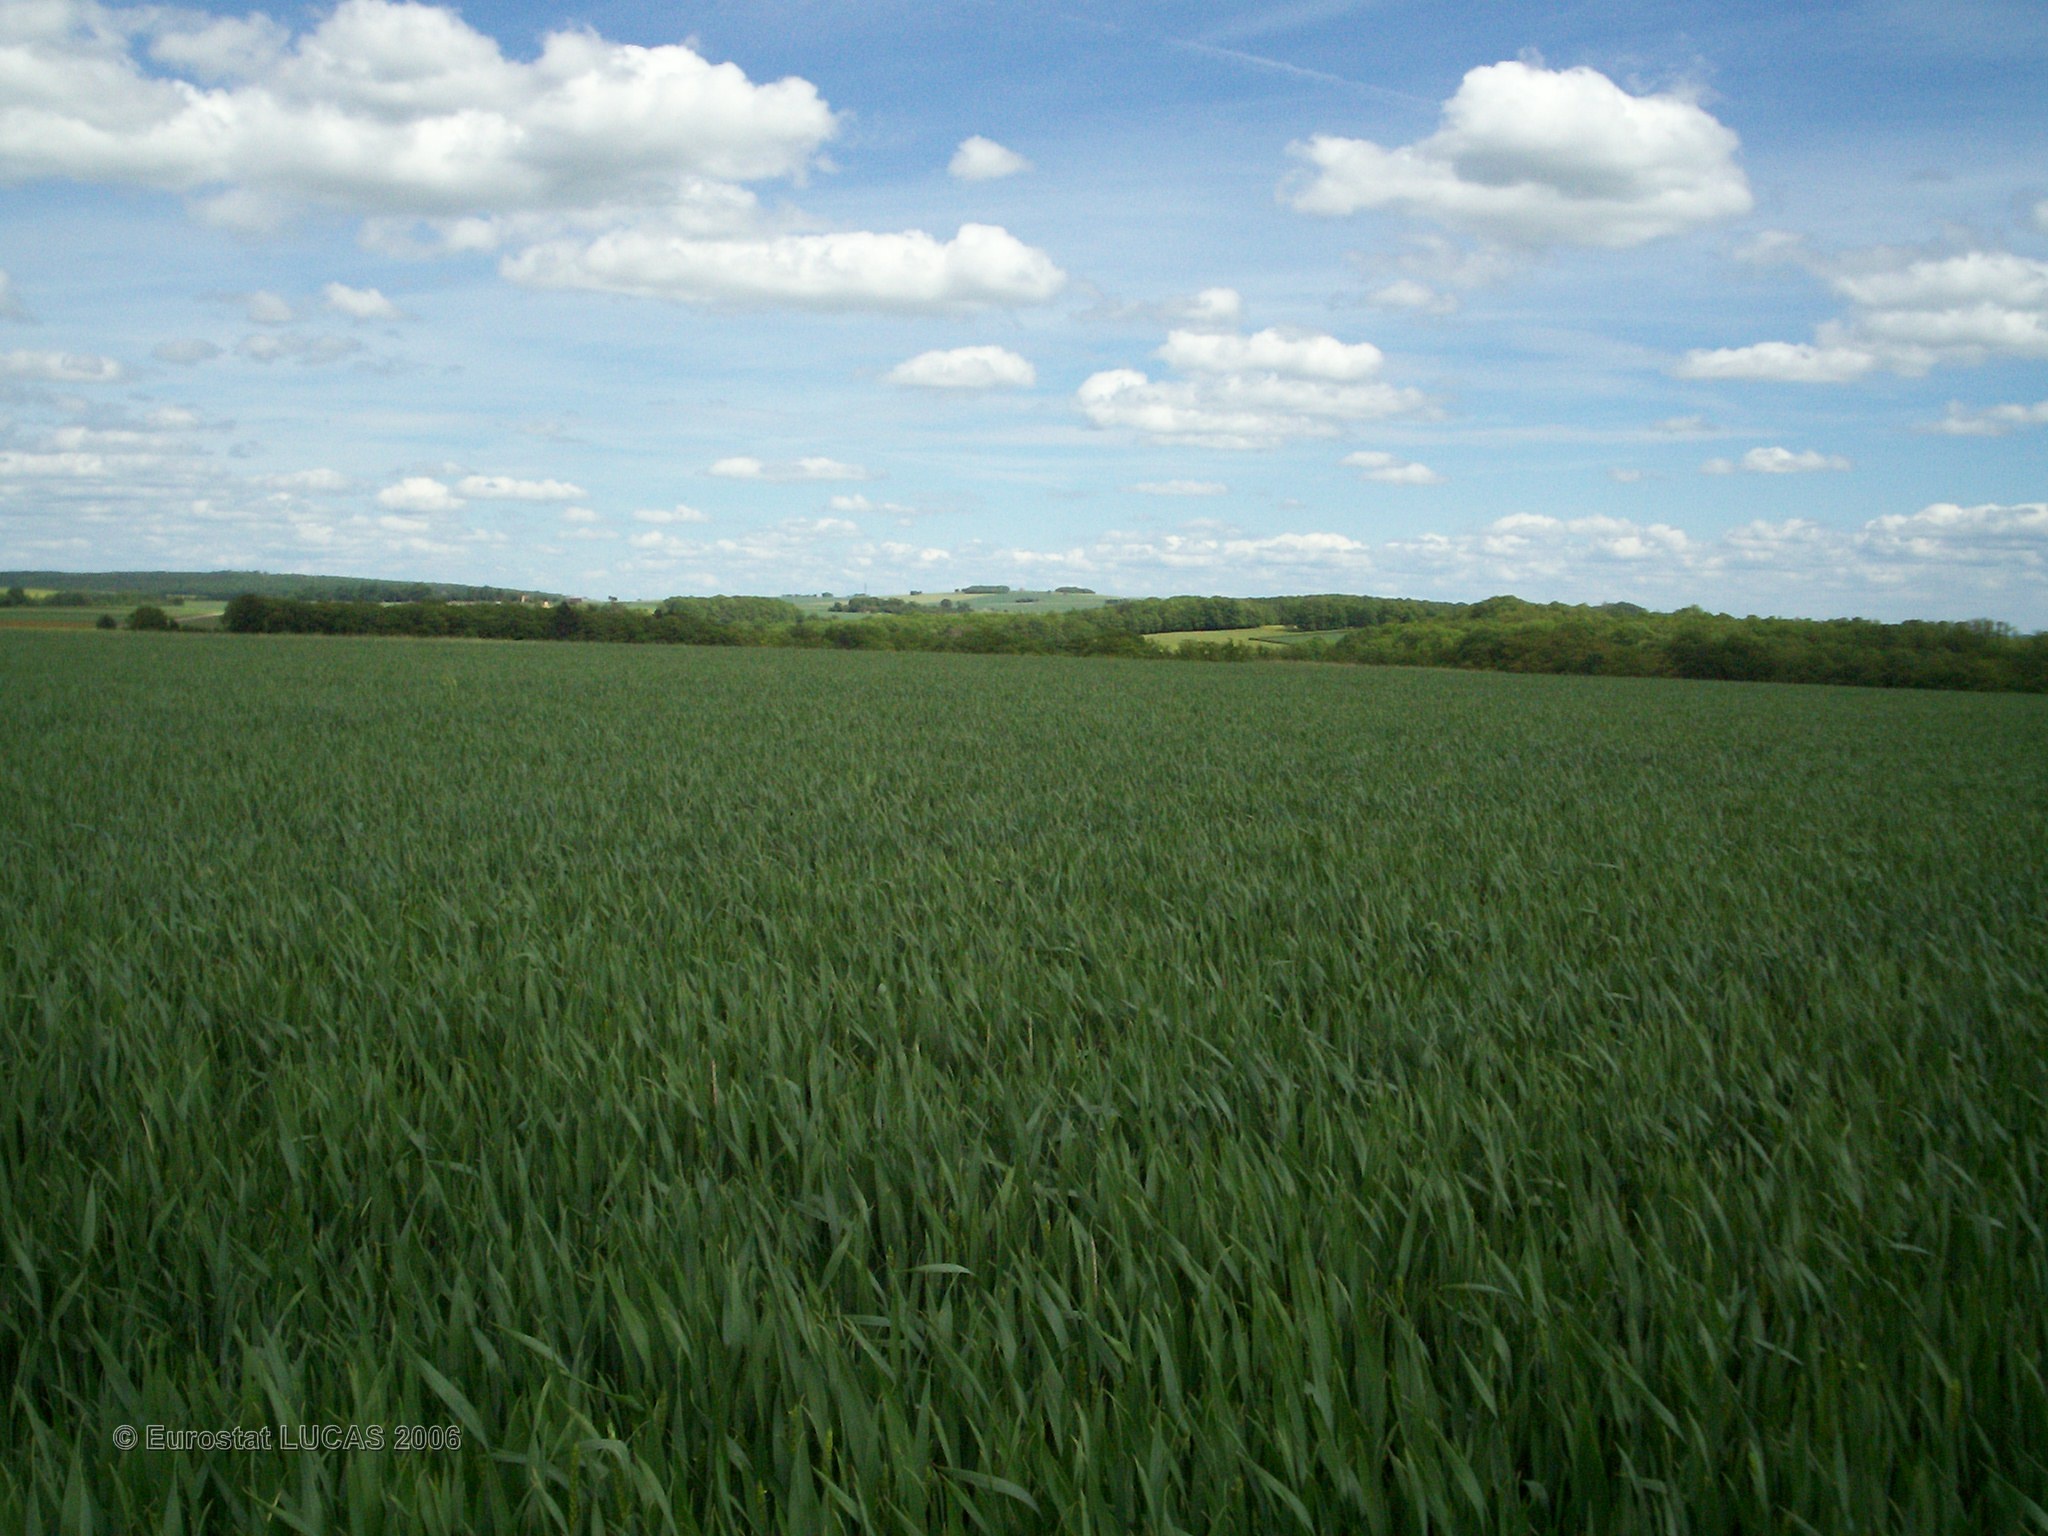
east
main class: Cropland
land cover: Common wheat
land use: Agriculture (excluding fallow land and kitchen gardens)
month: May
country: FR
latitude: 47.5594
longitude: 4.0838
